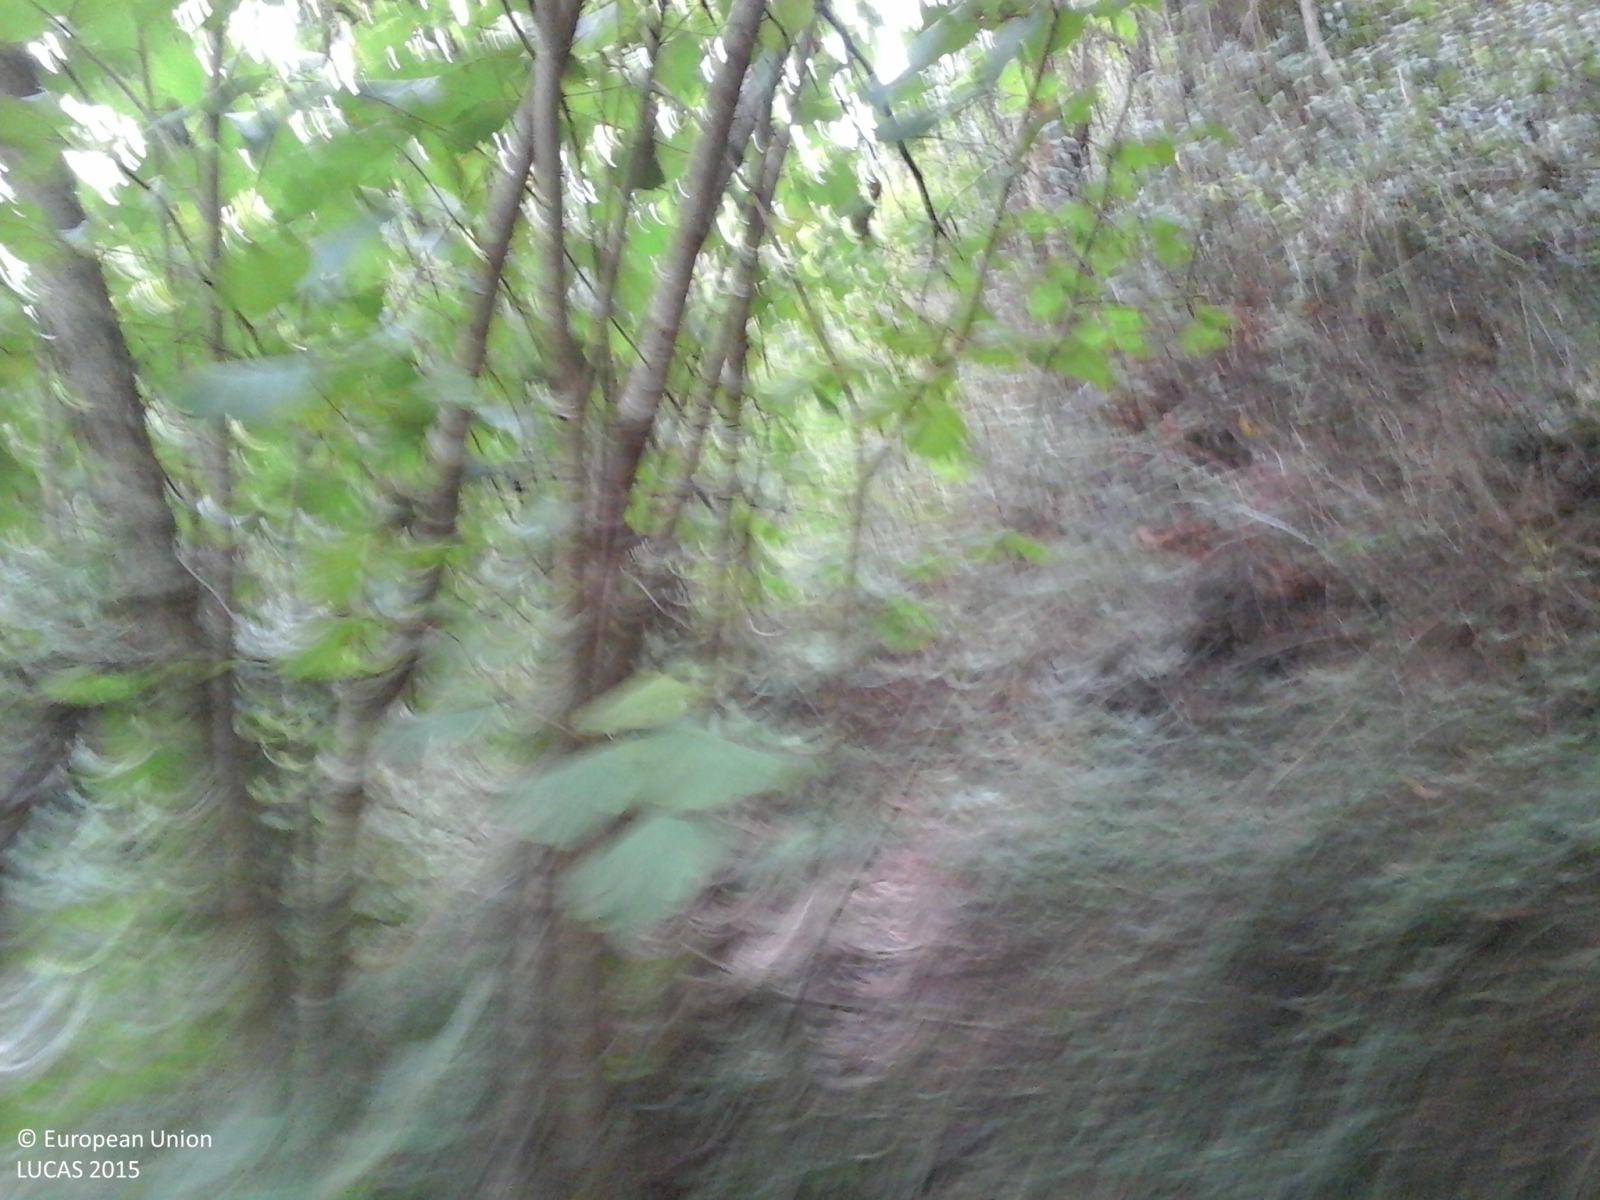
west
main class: Woodland
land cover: Broadleaved woodland
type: thermophilous deciduous forest
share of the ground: > 75 %
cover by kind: broadleaved forest trees 100 %
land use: Forestry
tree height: > 5 m
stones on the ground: 25 - 50 %
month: September
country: IT
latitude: 44.3666
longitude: 9.3615
